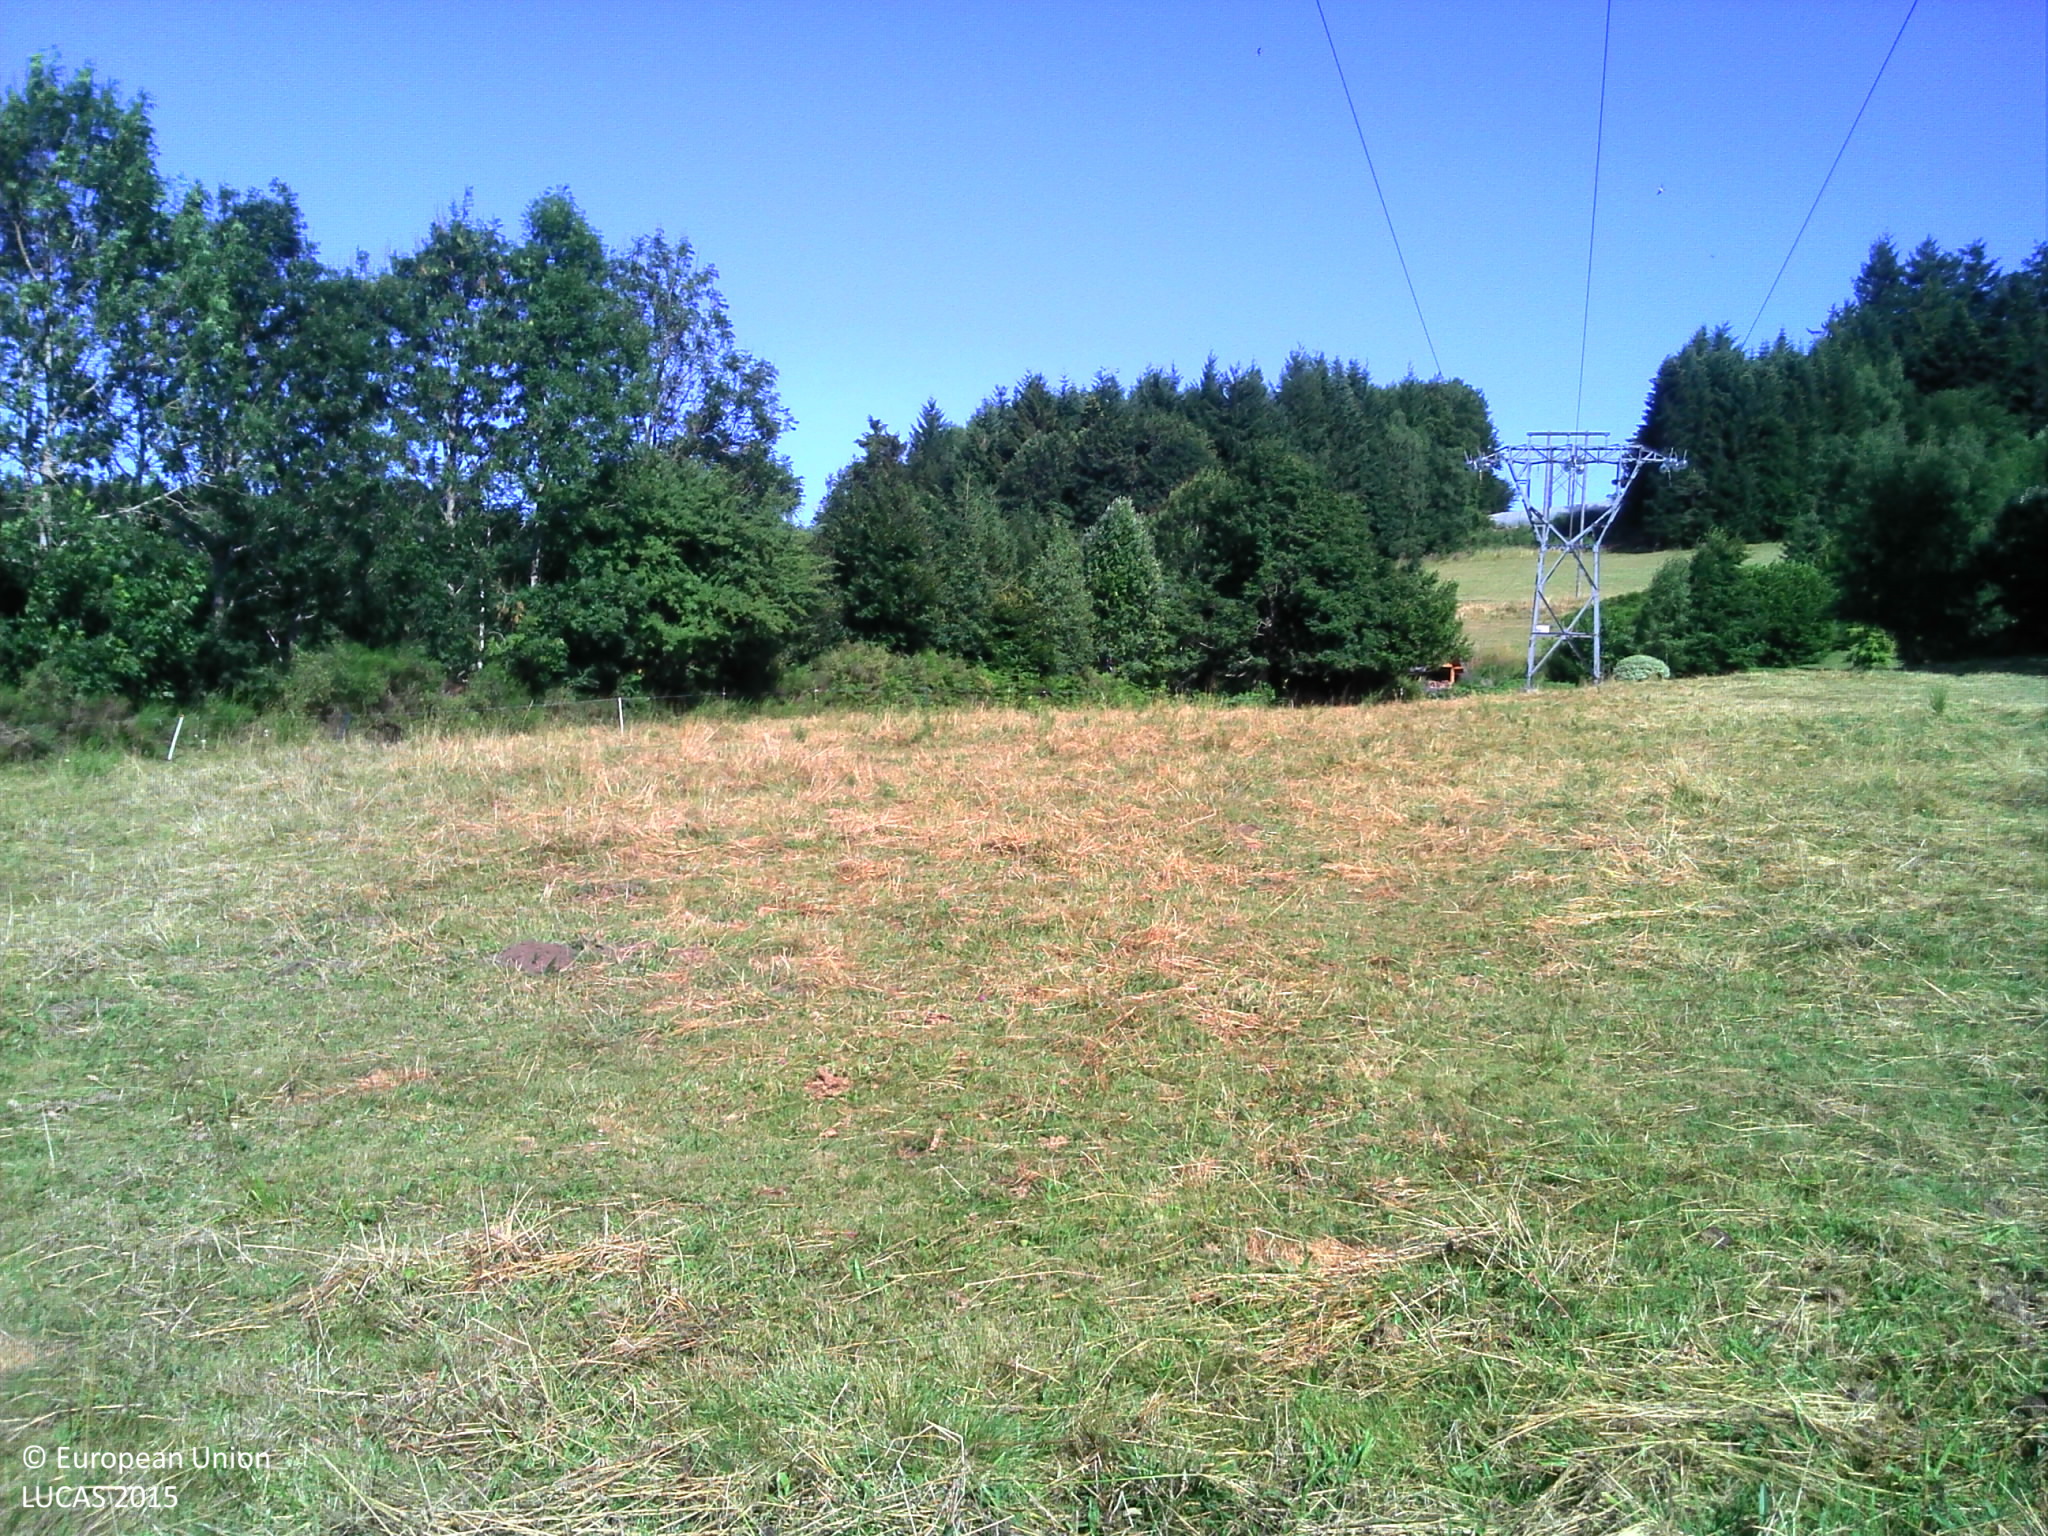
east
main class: Grassland
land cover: Grassland without tree/shrub cover
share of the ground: > 75 %
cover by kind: herbaceous plants 100 %
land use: Agriculture (excluding fallow land and kitchen gardens)
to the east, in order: Grassland without tree/shrub cover; Electric lines; Grassland without tree/shrub cover; Fences; Abandoned hedges; Grassland without tree/shrub cover; Fences; Lines of trees; Grassland without tree/shrub cover; Fences; Lines of trees; Grassland without tree/shrub cover
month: July
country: FR
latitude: 45.0947
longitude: 4.2484
